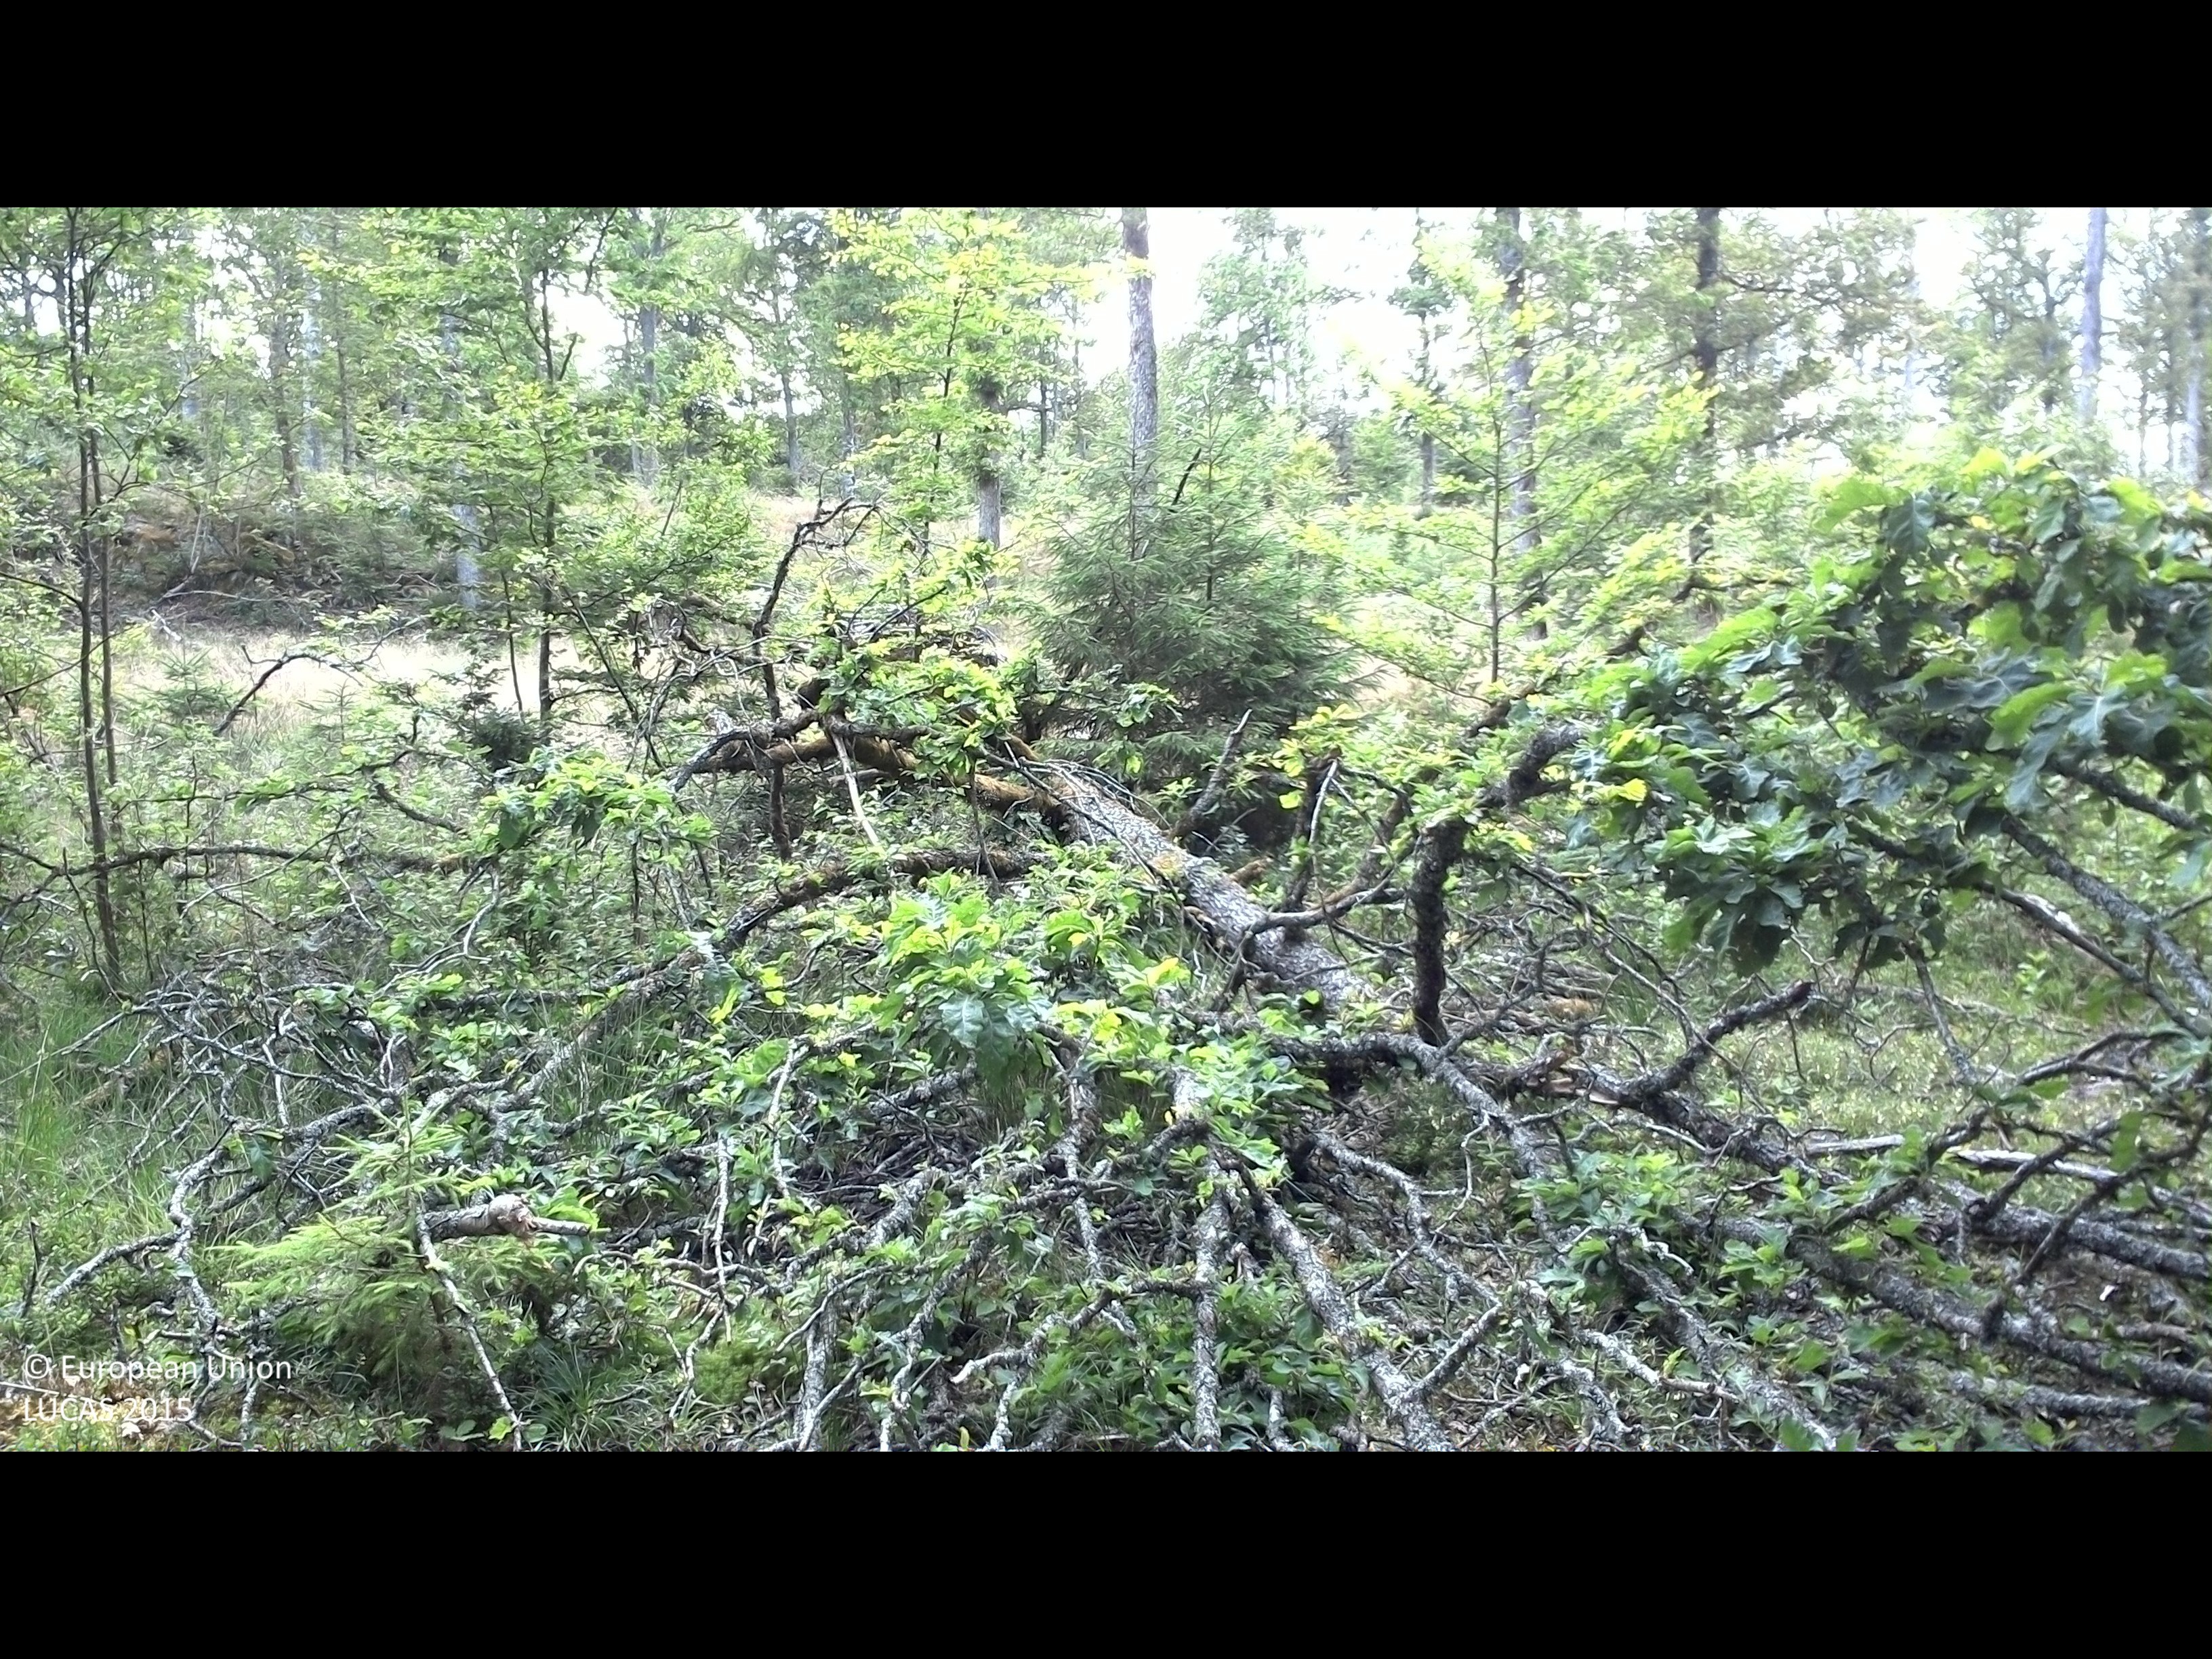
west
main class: Woodland
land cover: Spruce dominated mixed woodland
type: boreal forest
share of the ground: 50 - 75 %
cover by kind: coniferous forest trees 35 %, shrubs 30 %, broadleaved forest trees 15 %, herbaceous plants 10 %, lichens and mosses 10 %
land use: Forestry
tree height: > 5 m
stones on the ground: < 10 %
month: July
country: SE
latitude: 56.3477
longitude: 15.3223
